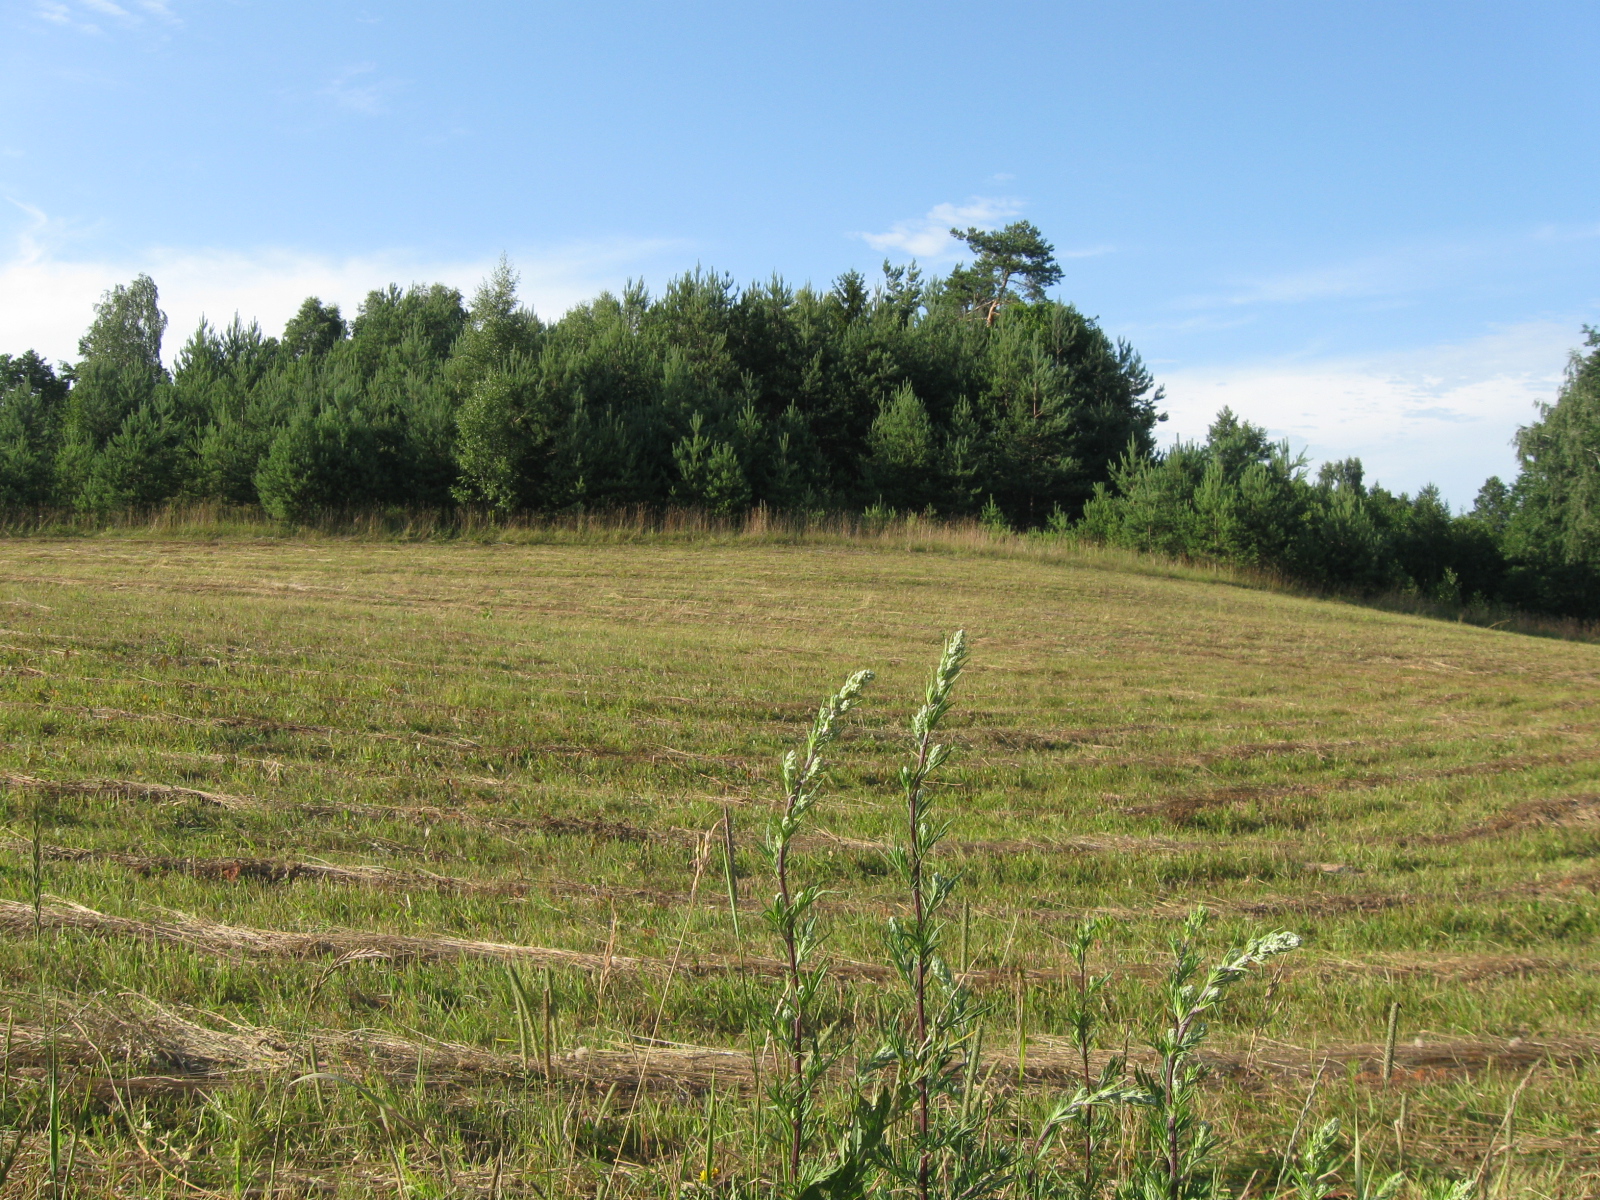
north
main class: Grassland
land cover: Spontaneously vegetated surfaces
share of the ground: > 75 %
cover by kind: herbaceous plants 100 %
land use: Agriculture (excluding fallow land and kitchen gardens)
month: July
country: LT
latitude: 54.4549
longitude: 24.3993
